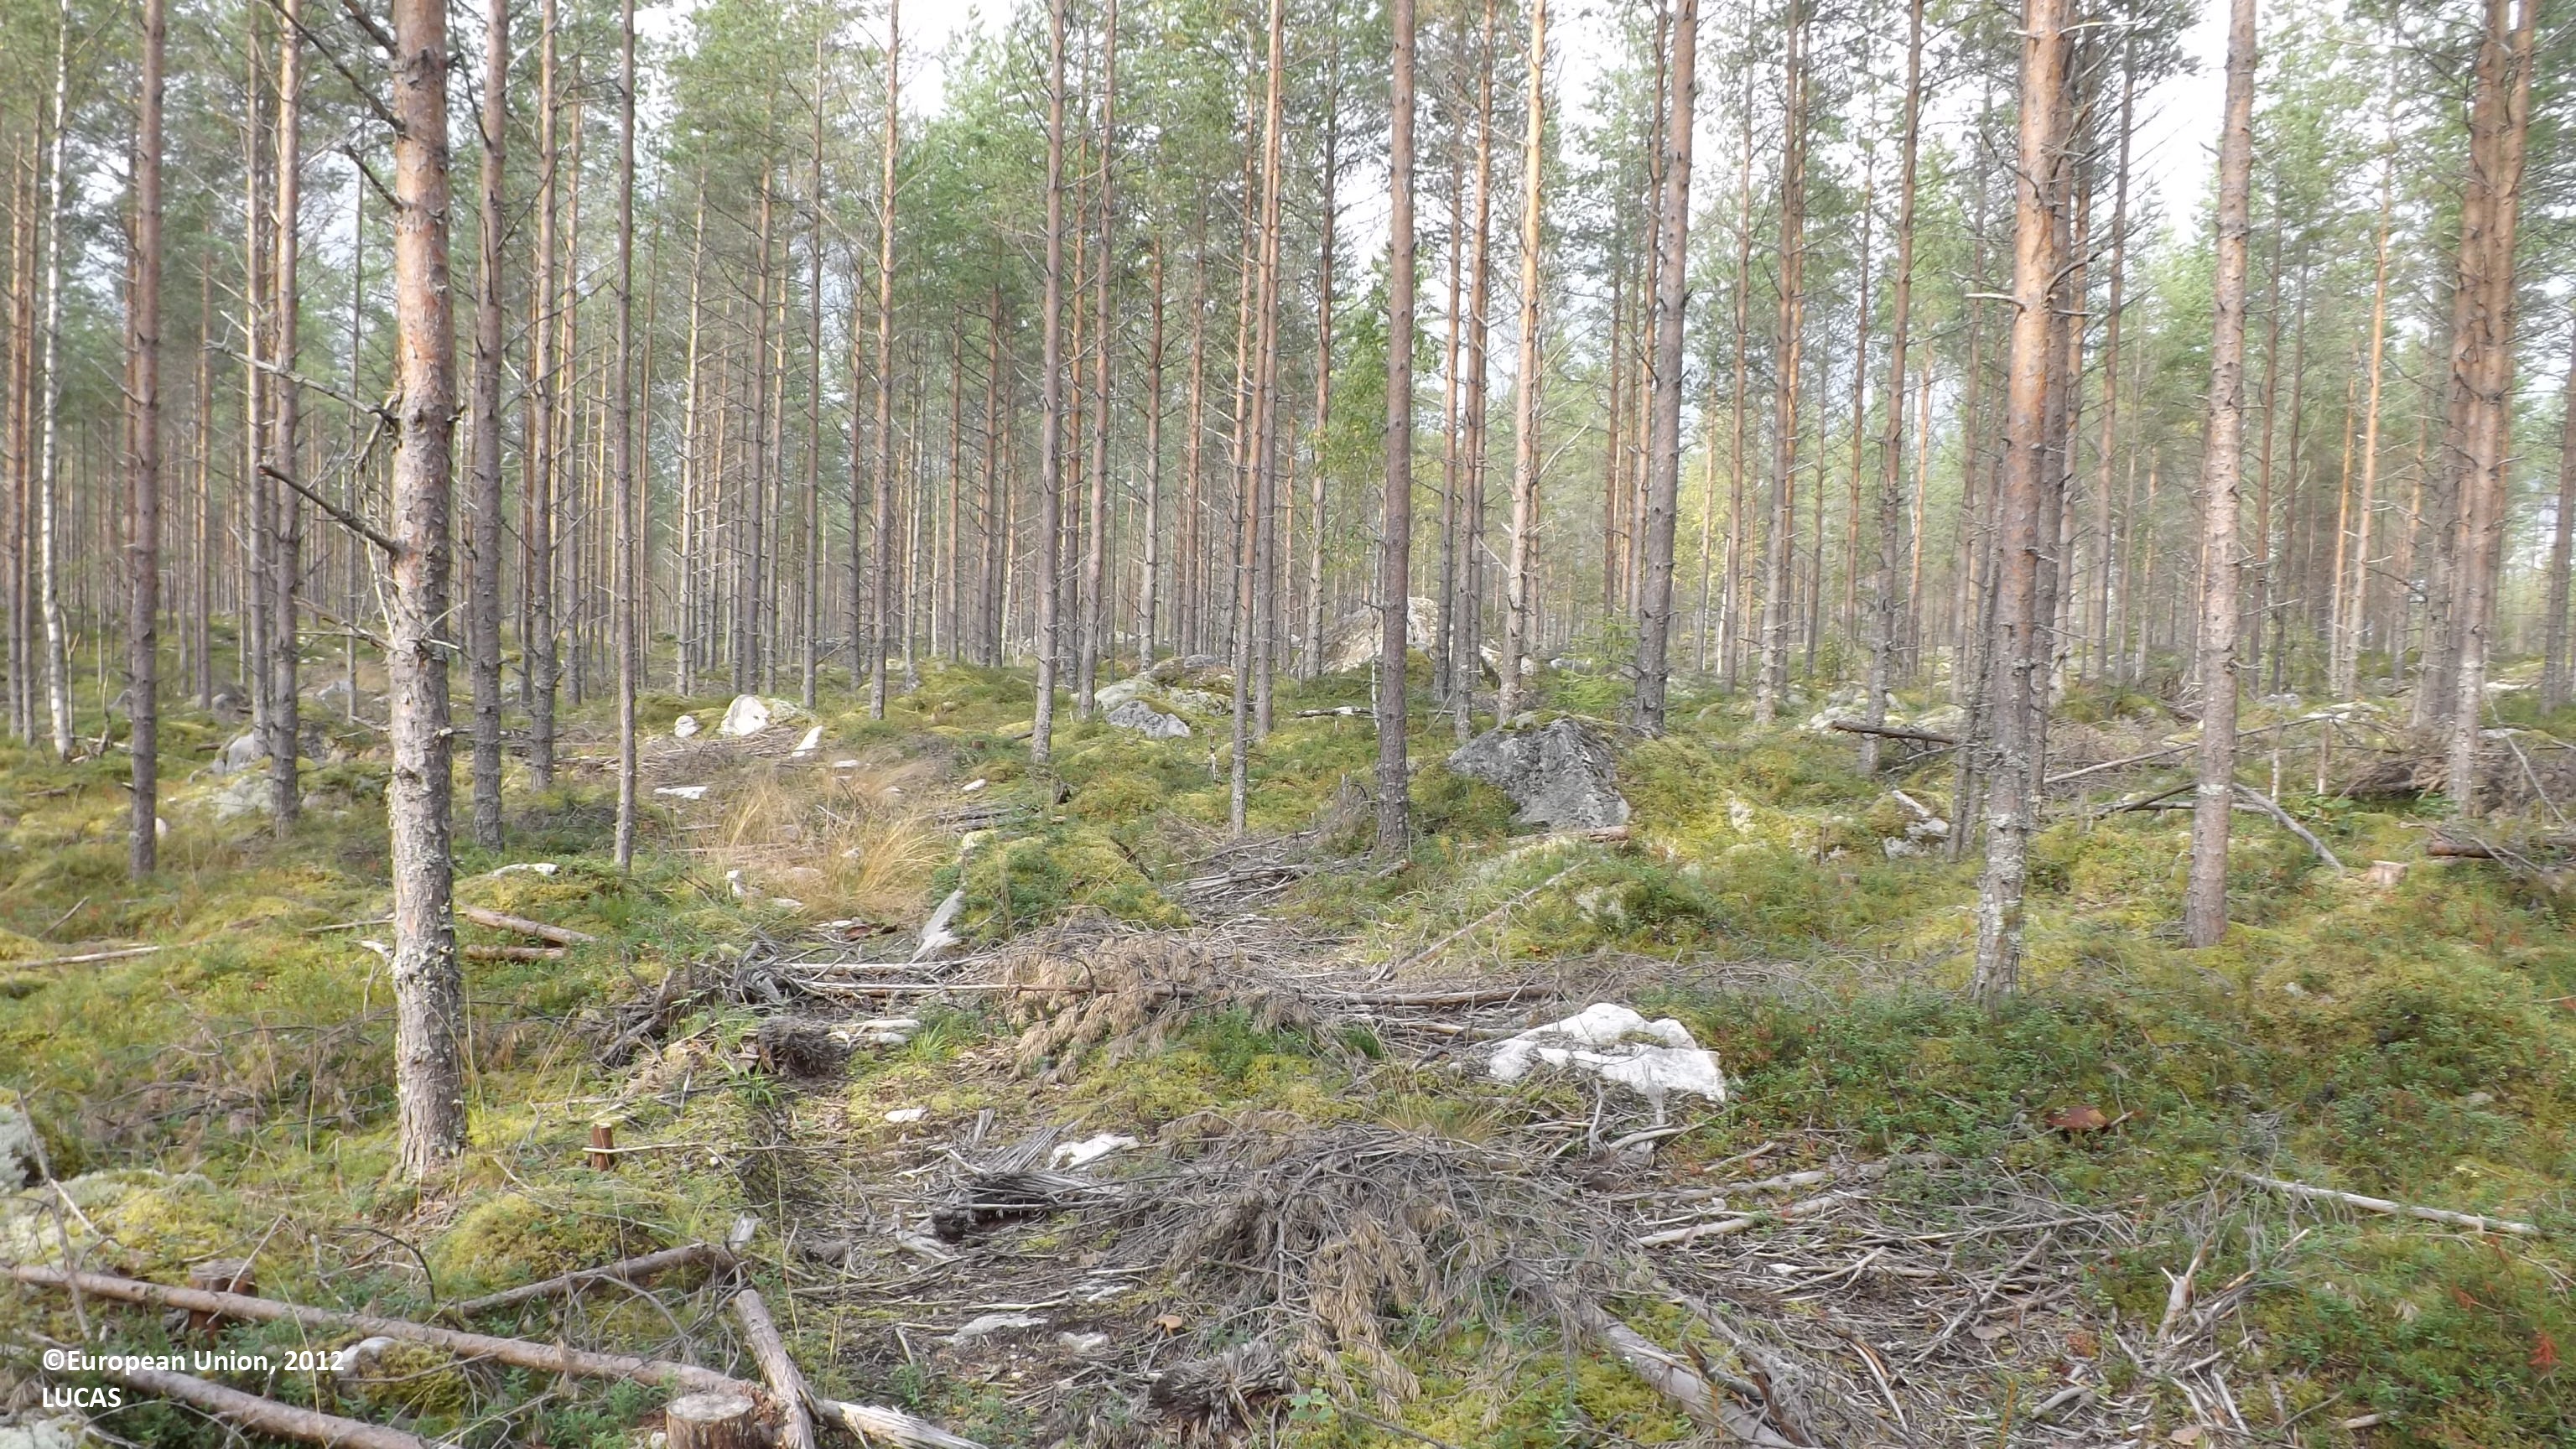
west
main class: Woodland
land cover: Pine dominated coniferous woodland
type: boreal forest
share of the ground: 25 - 50 %
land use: Forestry
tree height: > 5 m
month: August
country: FI
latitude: 63.7595
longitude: 23.7470
